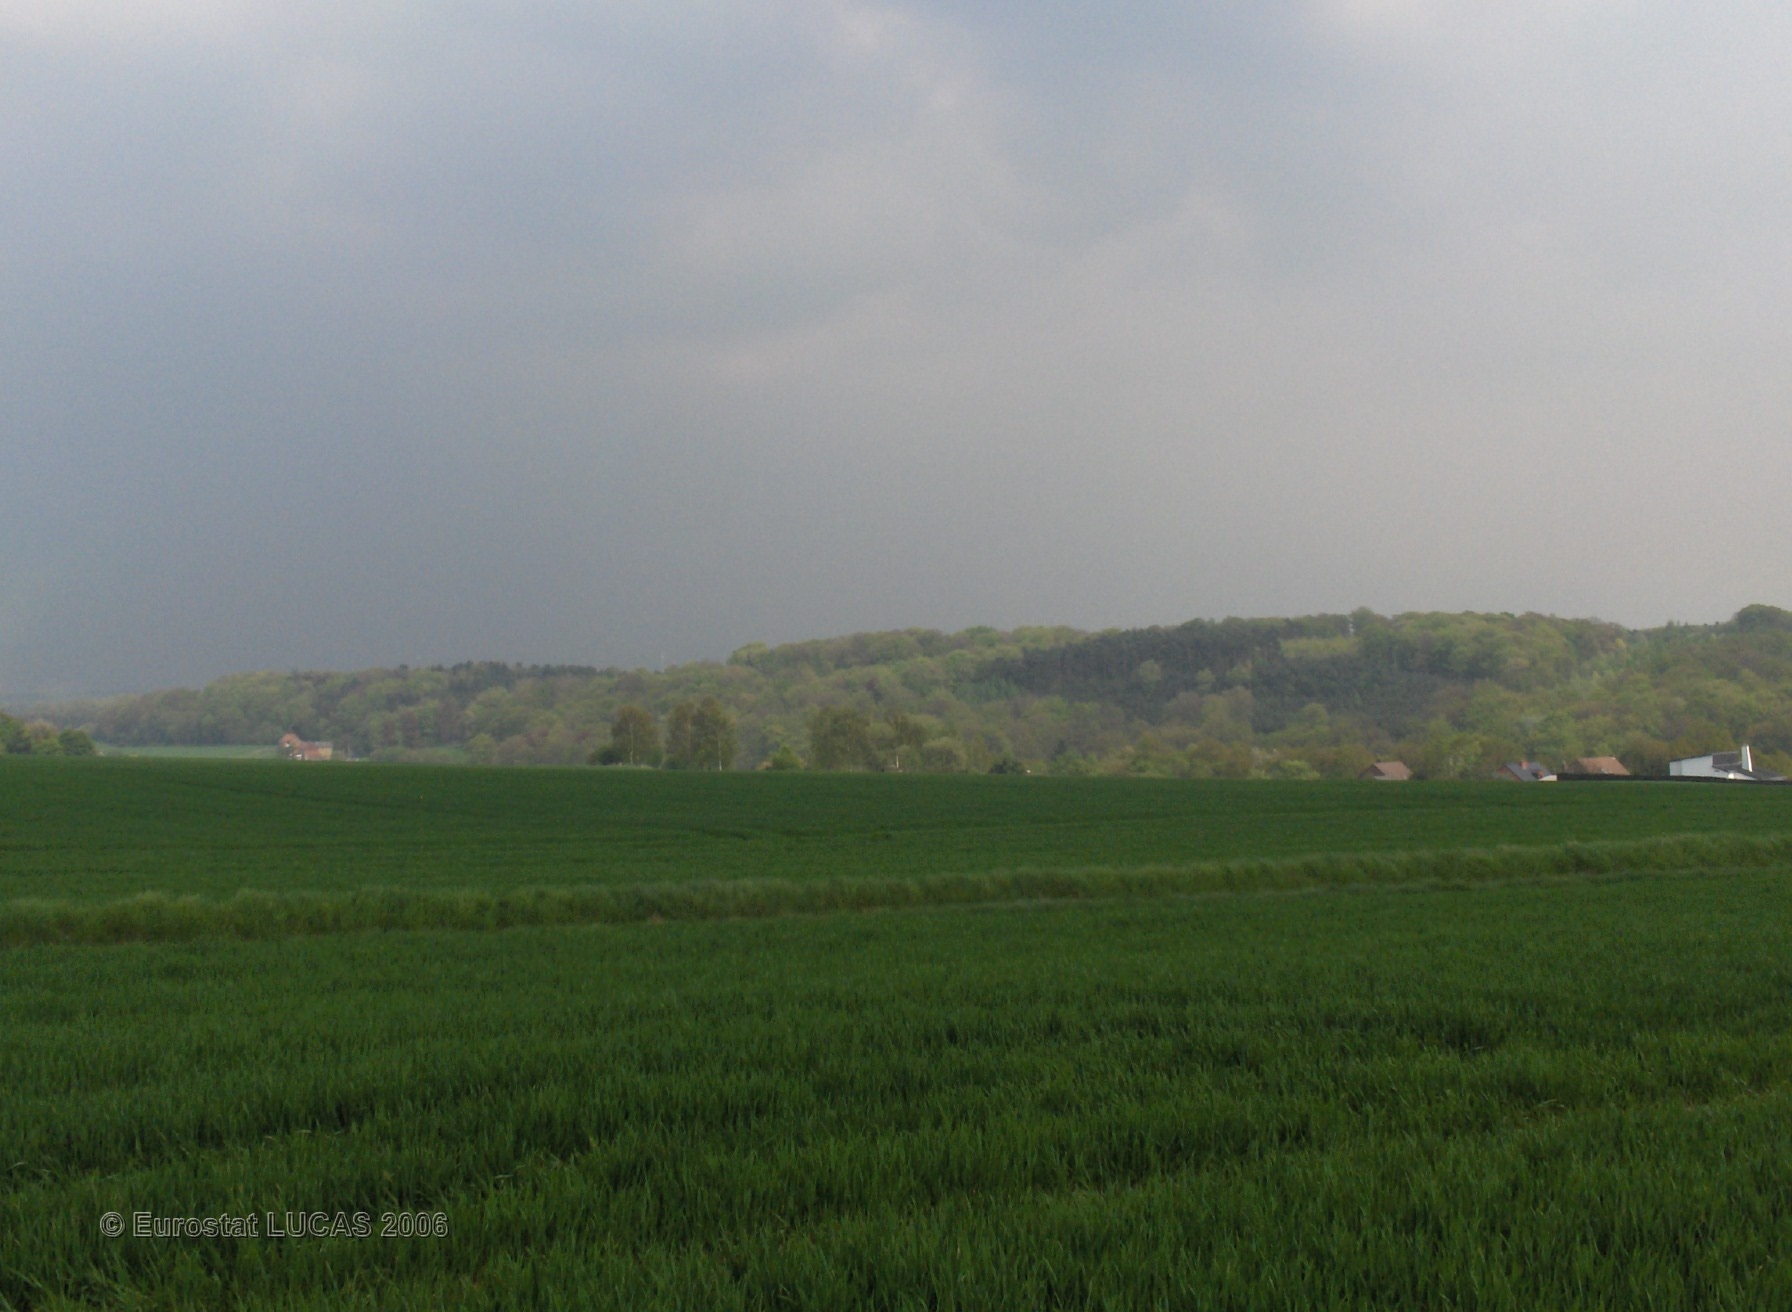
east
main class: Cropland
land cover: Common wheat
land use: Agriculture (excluding fallow land and kitchen gardens)
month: May
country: BE
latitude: 50.6295
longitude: 4.5248
